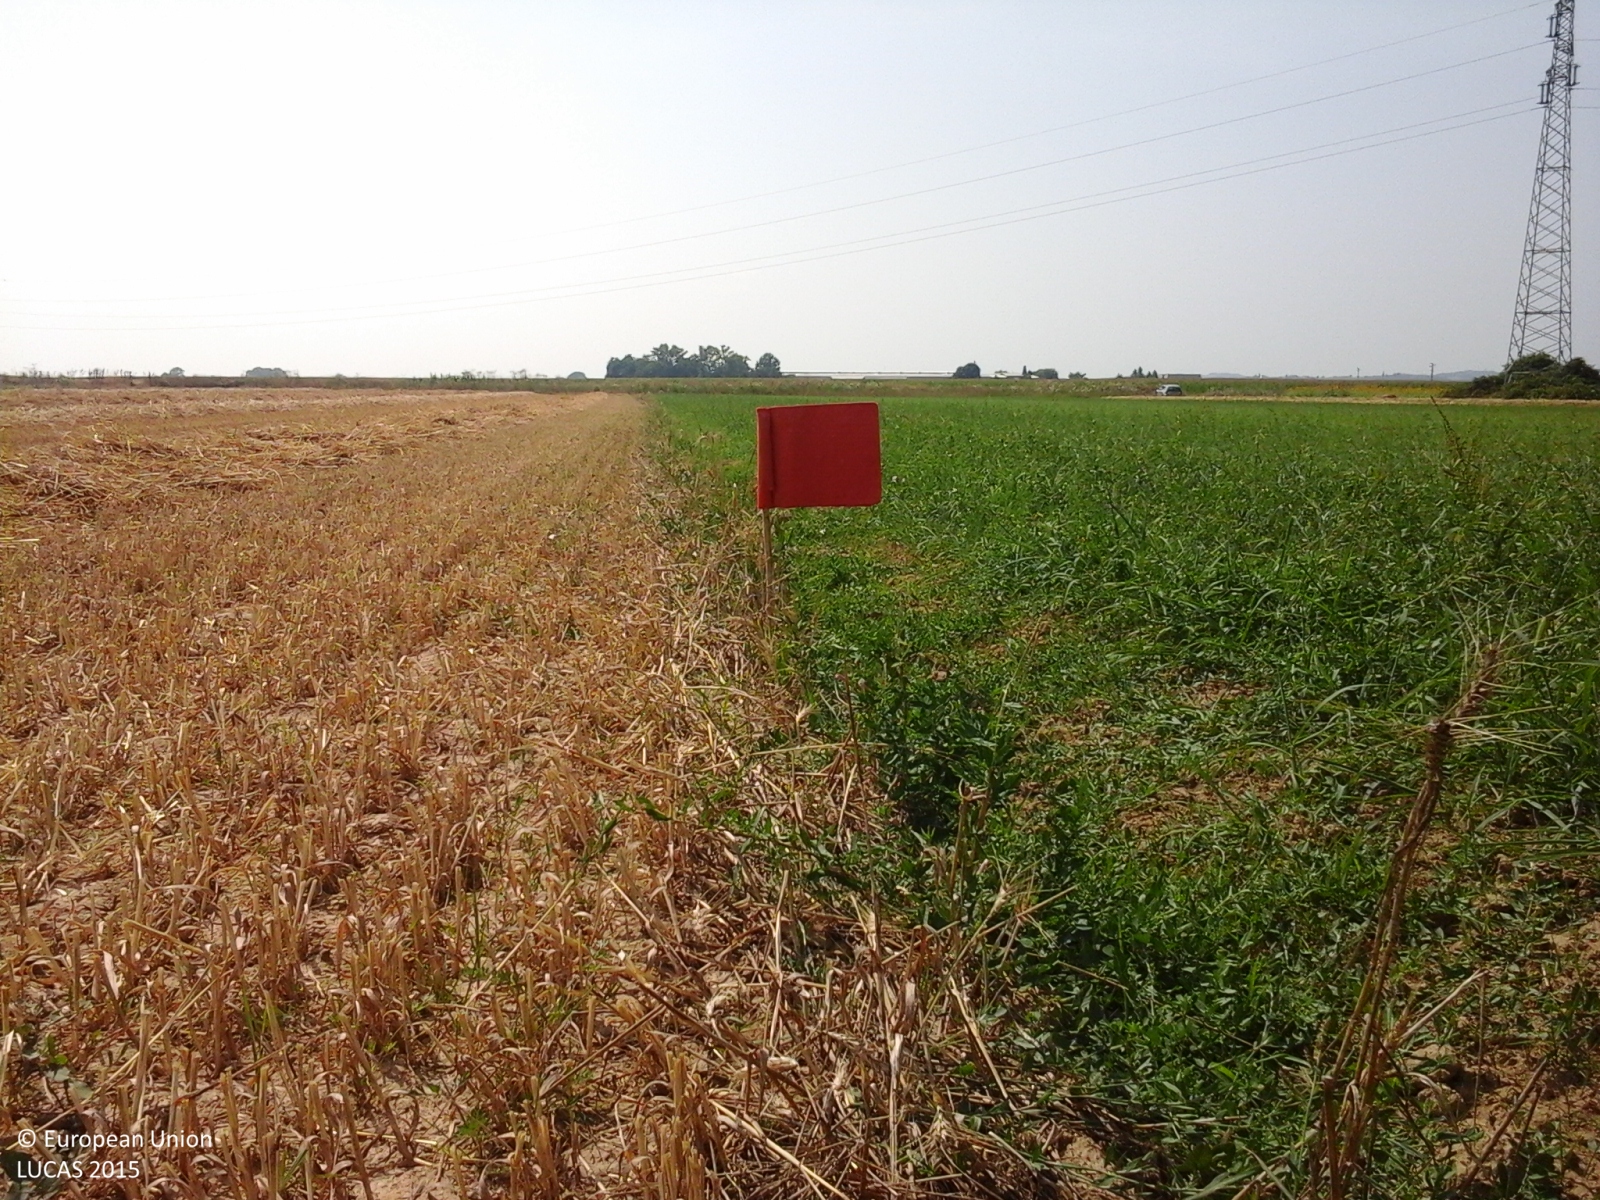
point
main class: Grassland
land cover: Spontaneously vegetated surfaces
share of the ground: > 75 %
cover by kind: herbaceous plants 100 %
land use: Fallow land
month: July
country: IT
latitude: 44.9352
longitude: 8.5203
